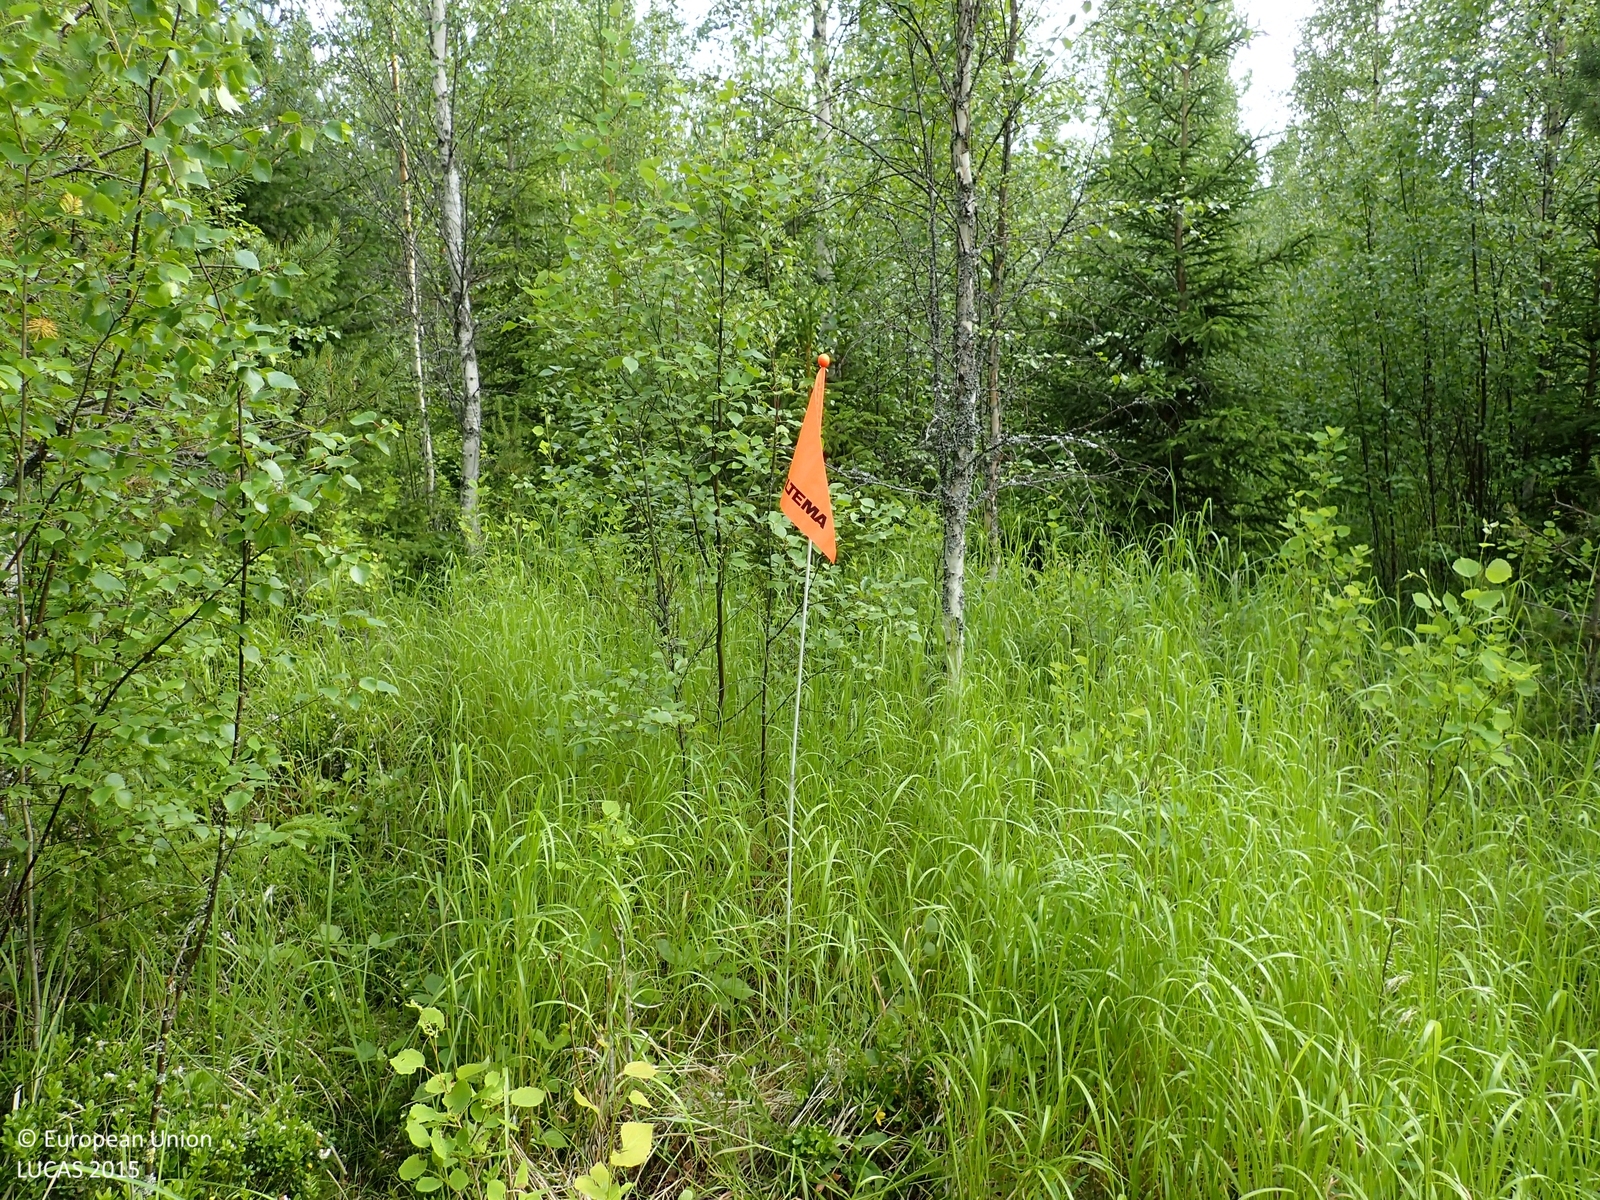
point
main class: Woodland
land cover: Pine dominated mixed woodland
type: boreal forest
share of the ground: 50 - 75 %
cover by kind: broadleaved forest trees 45 %, herbaceous plants 30 %, coniferous forest trees 15 %, shrubs 10 %
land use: Forestry
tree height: < 5 m
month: July
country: FI
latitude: 62.8080
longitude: 21.7540
